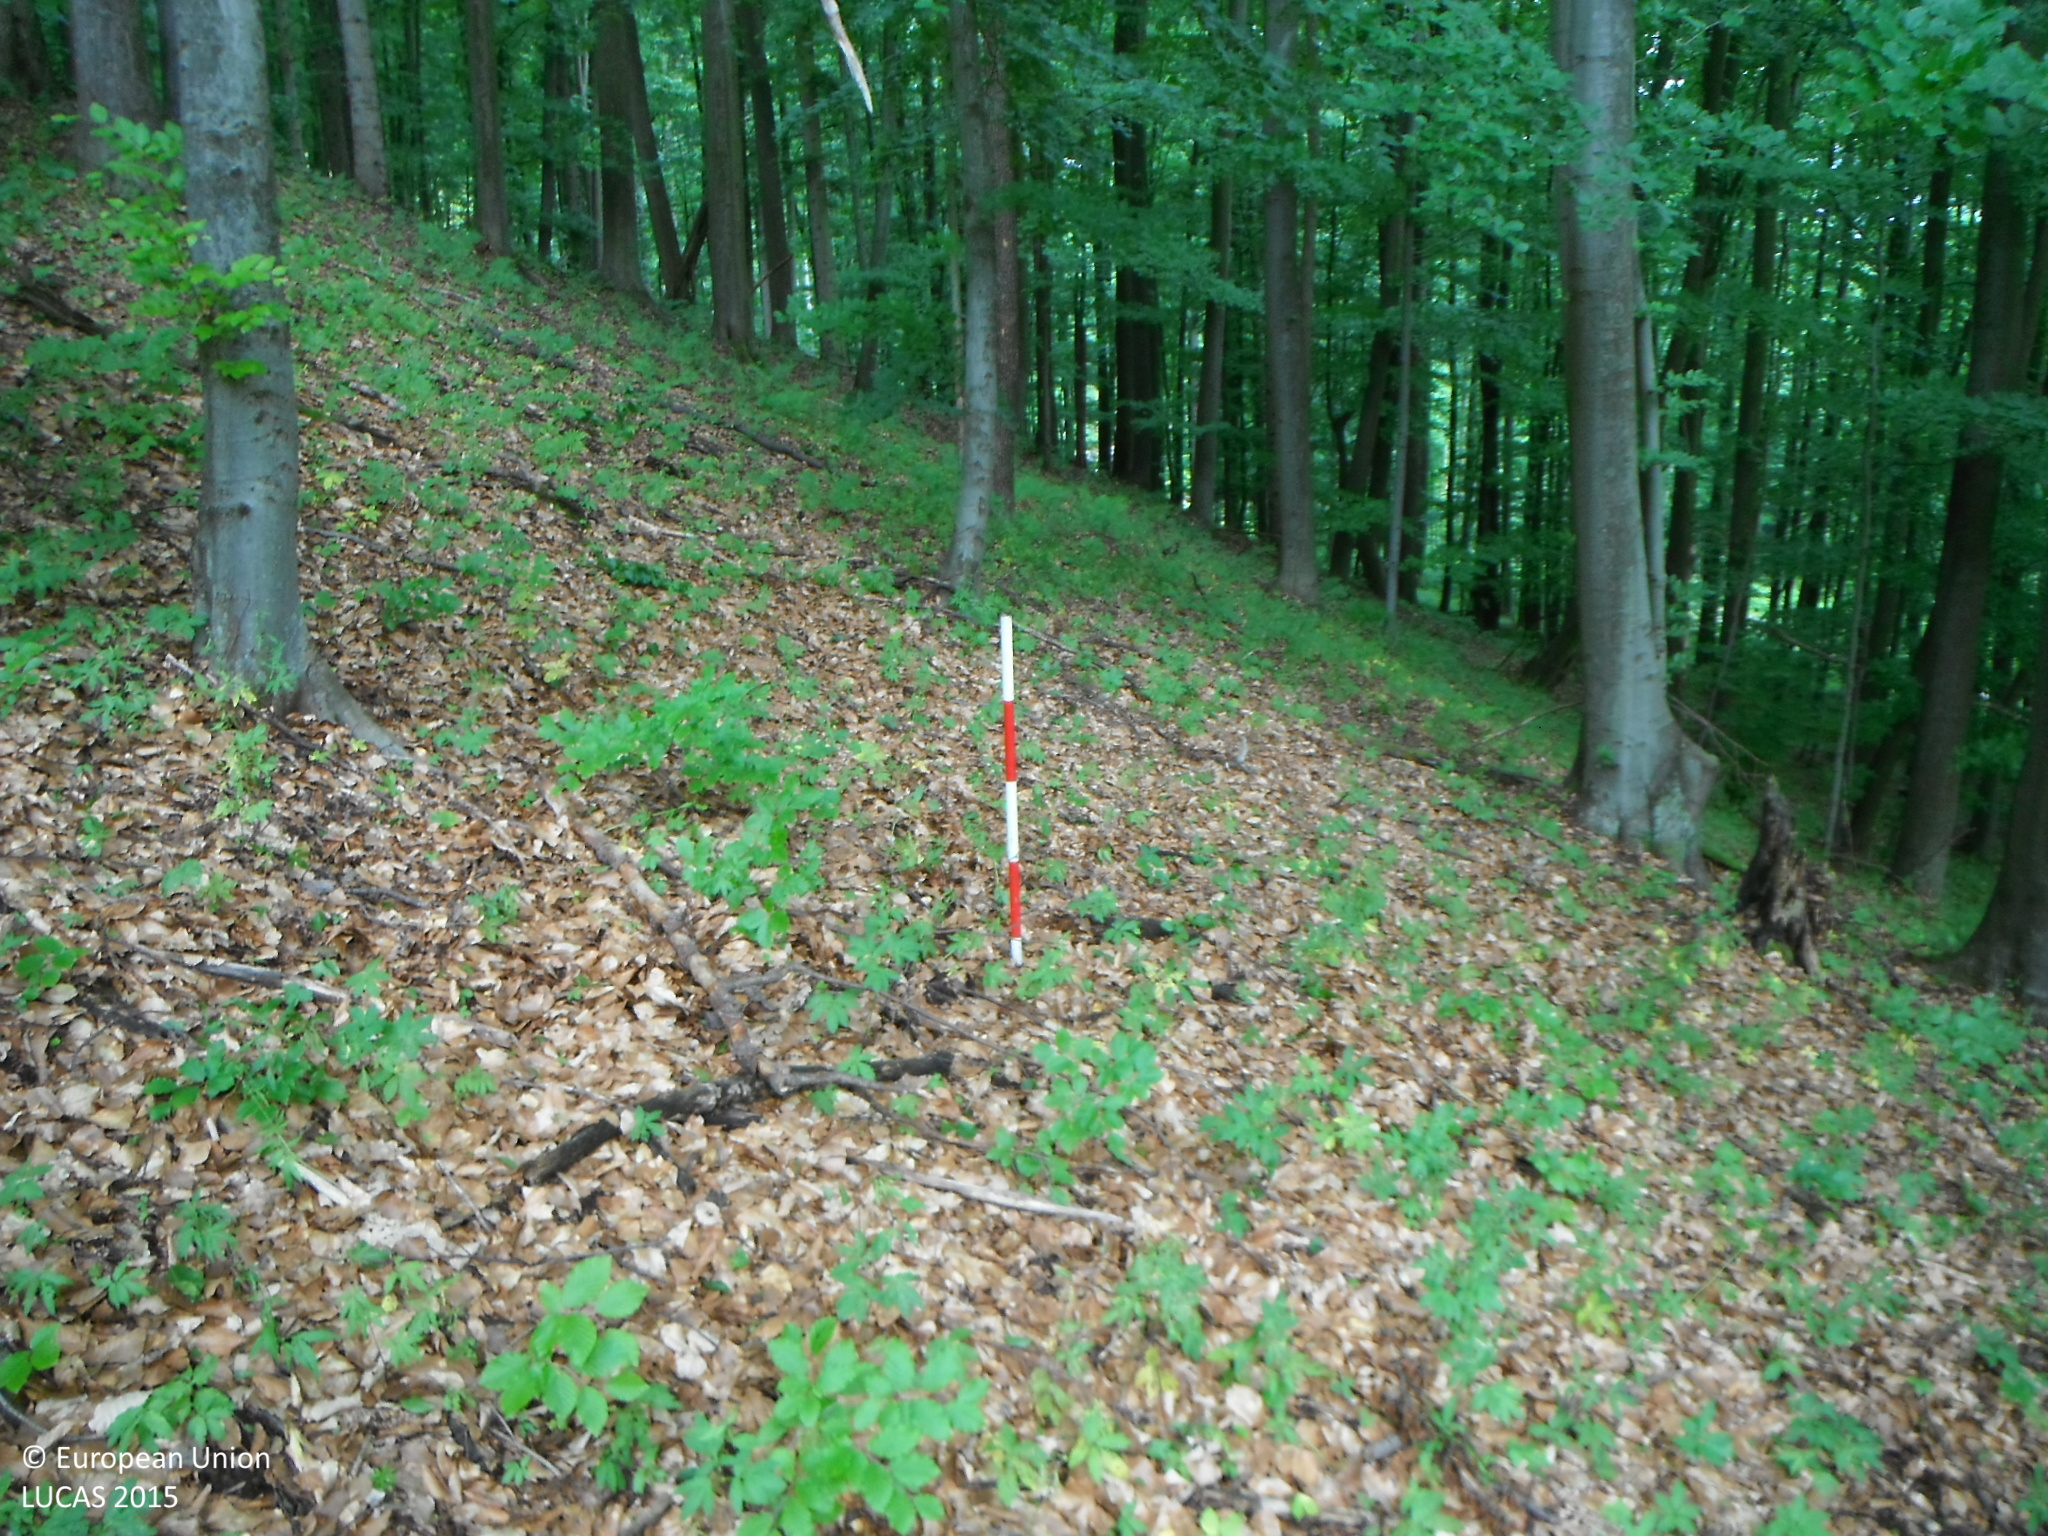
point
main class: Woodland
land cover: Other mixed woodland
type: mountainous beech forest
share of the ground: > 75 %
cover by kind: broadleaved forest trees 75 %, coniferous forest trees 25 %
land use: Forestry
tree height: > 5 m
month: May
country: SK
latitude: 48.4913
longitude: 18.9645
